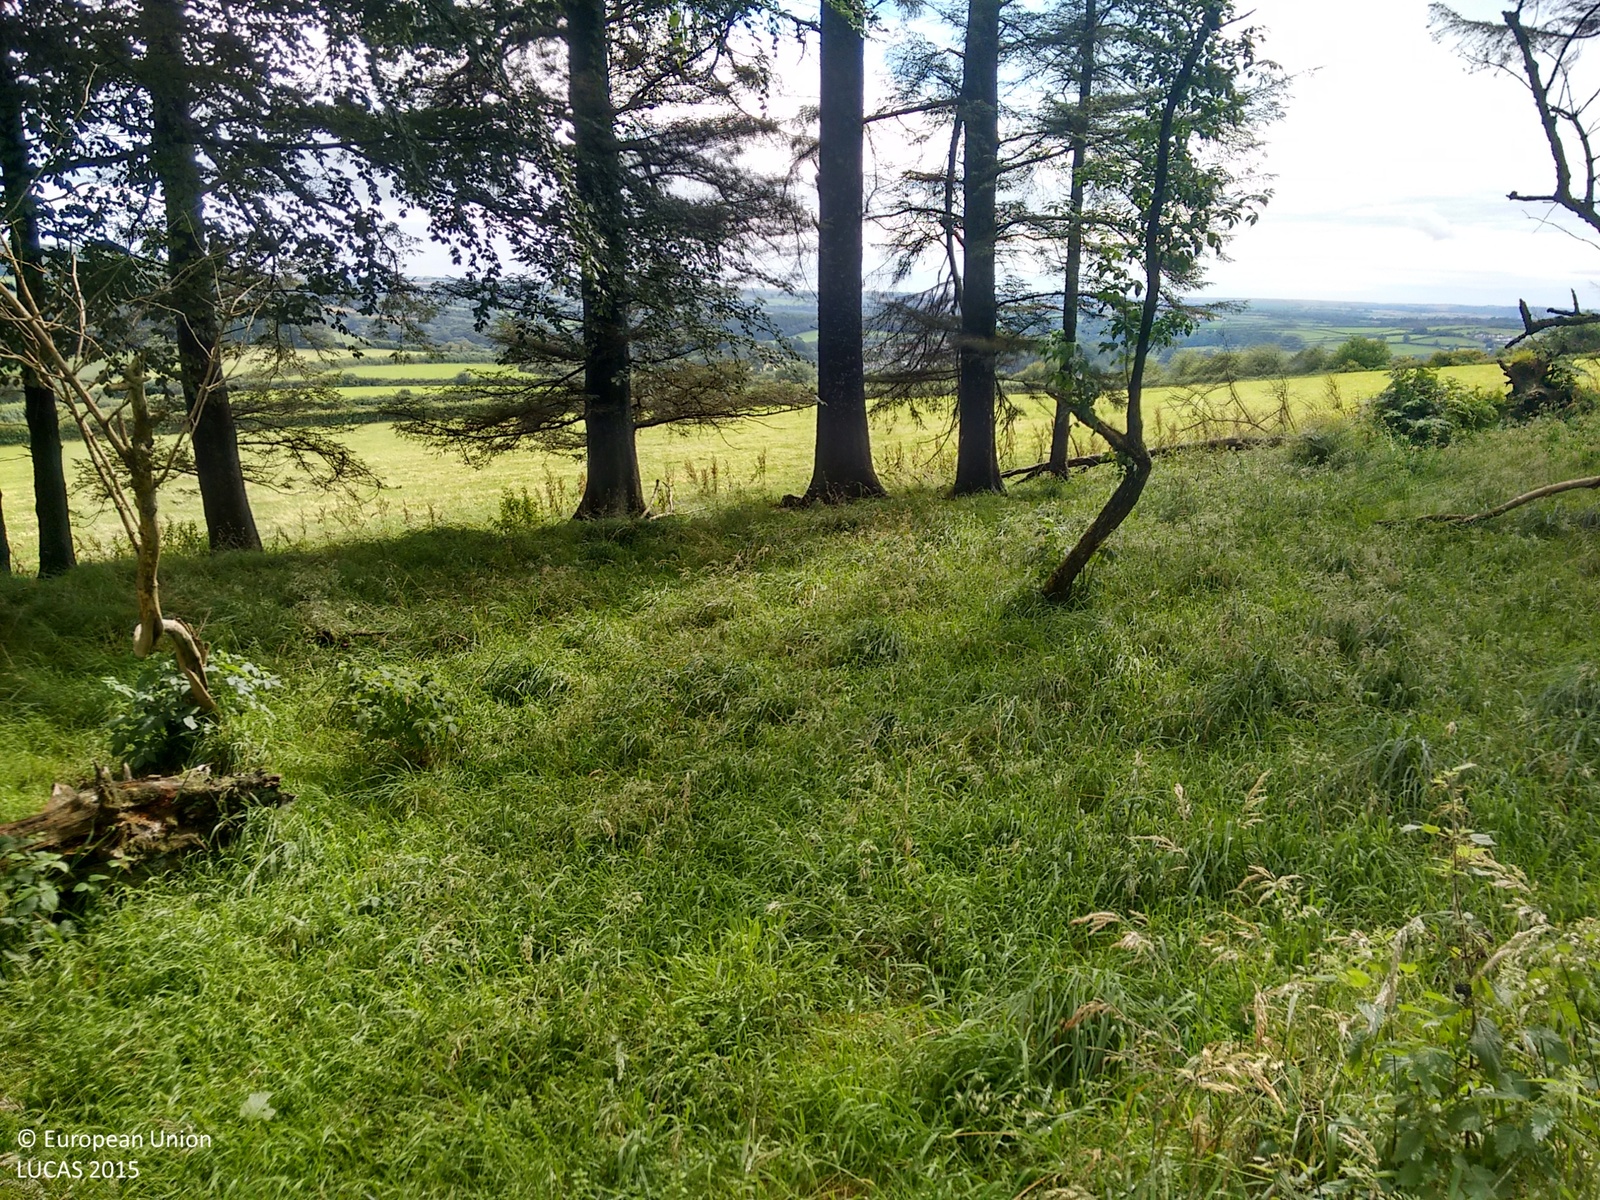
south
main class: Woodland
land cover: Spruce dominated coniferous woodland
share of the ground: > 75 %
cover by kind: coniferous forest trees 100 %
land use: Semi-natural and natural areas not in use
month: August
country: GB
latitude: 50.4335
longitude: -3.9601
